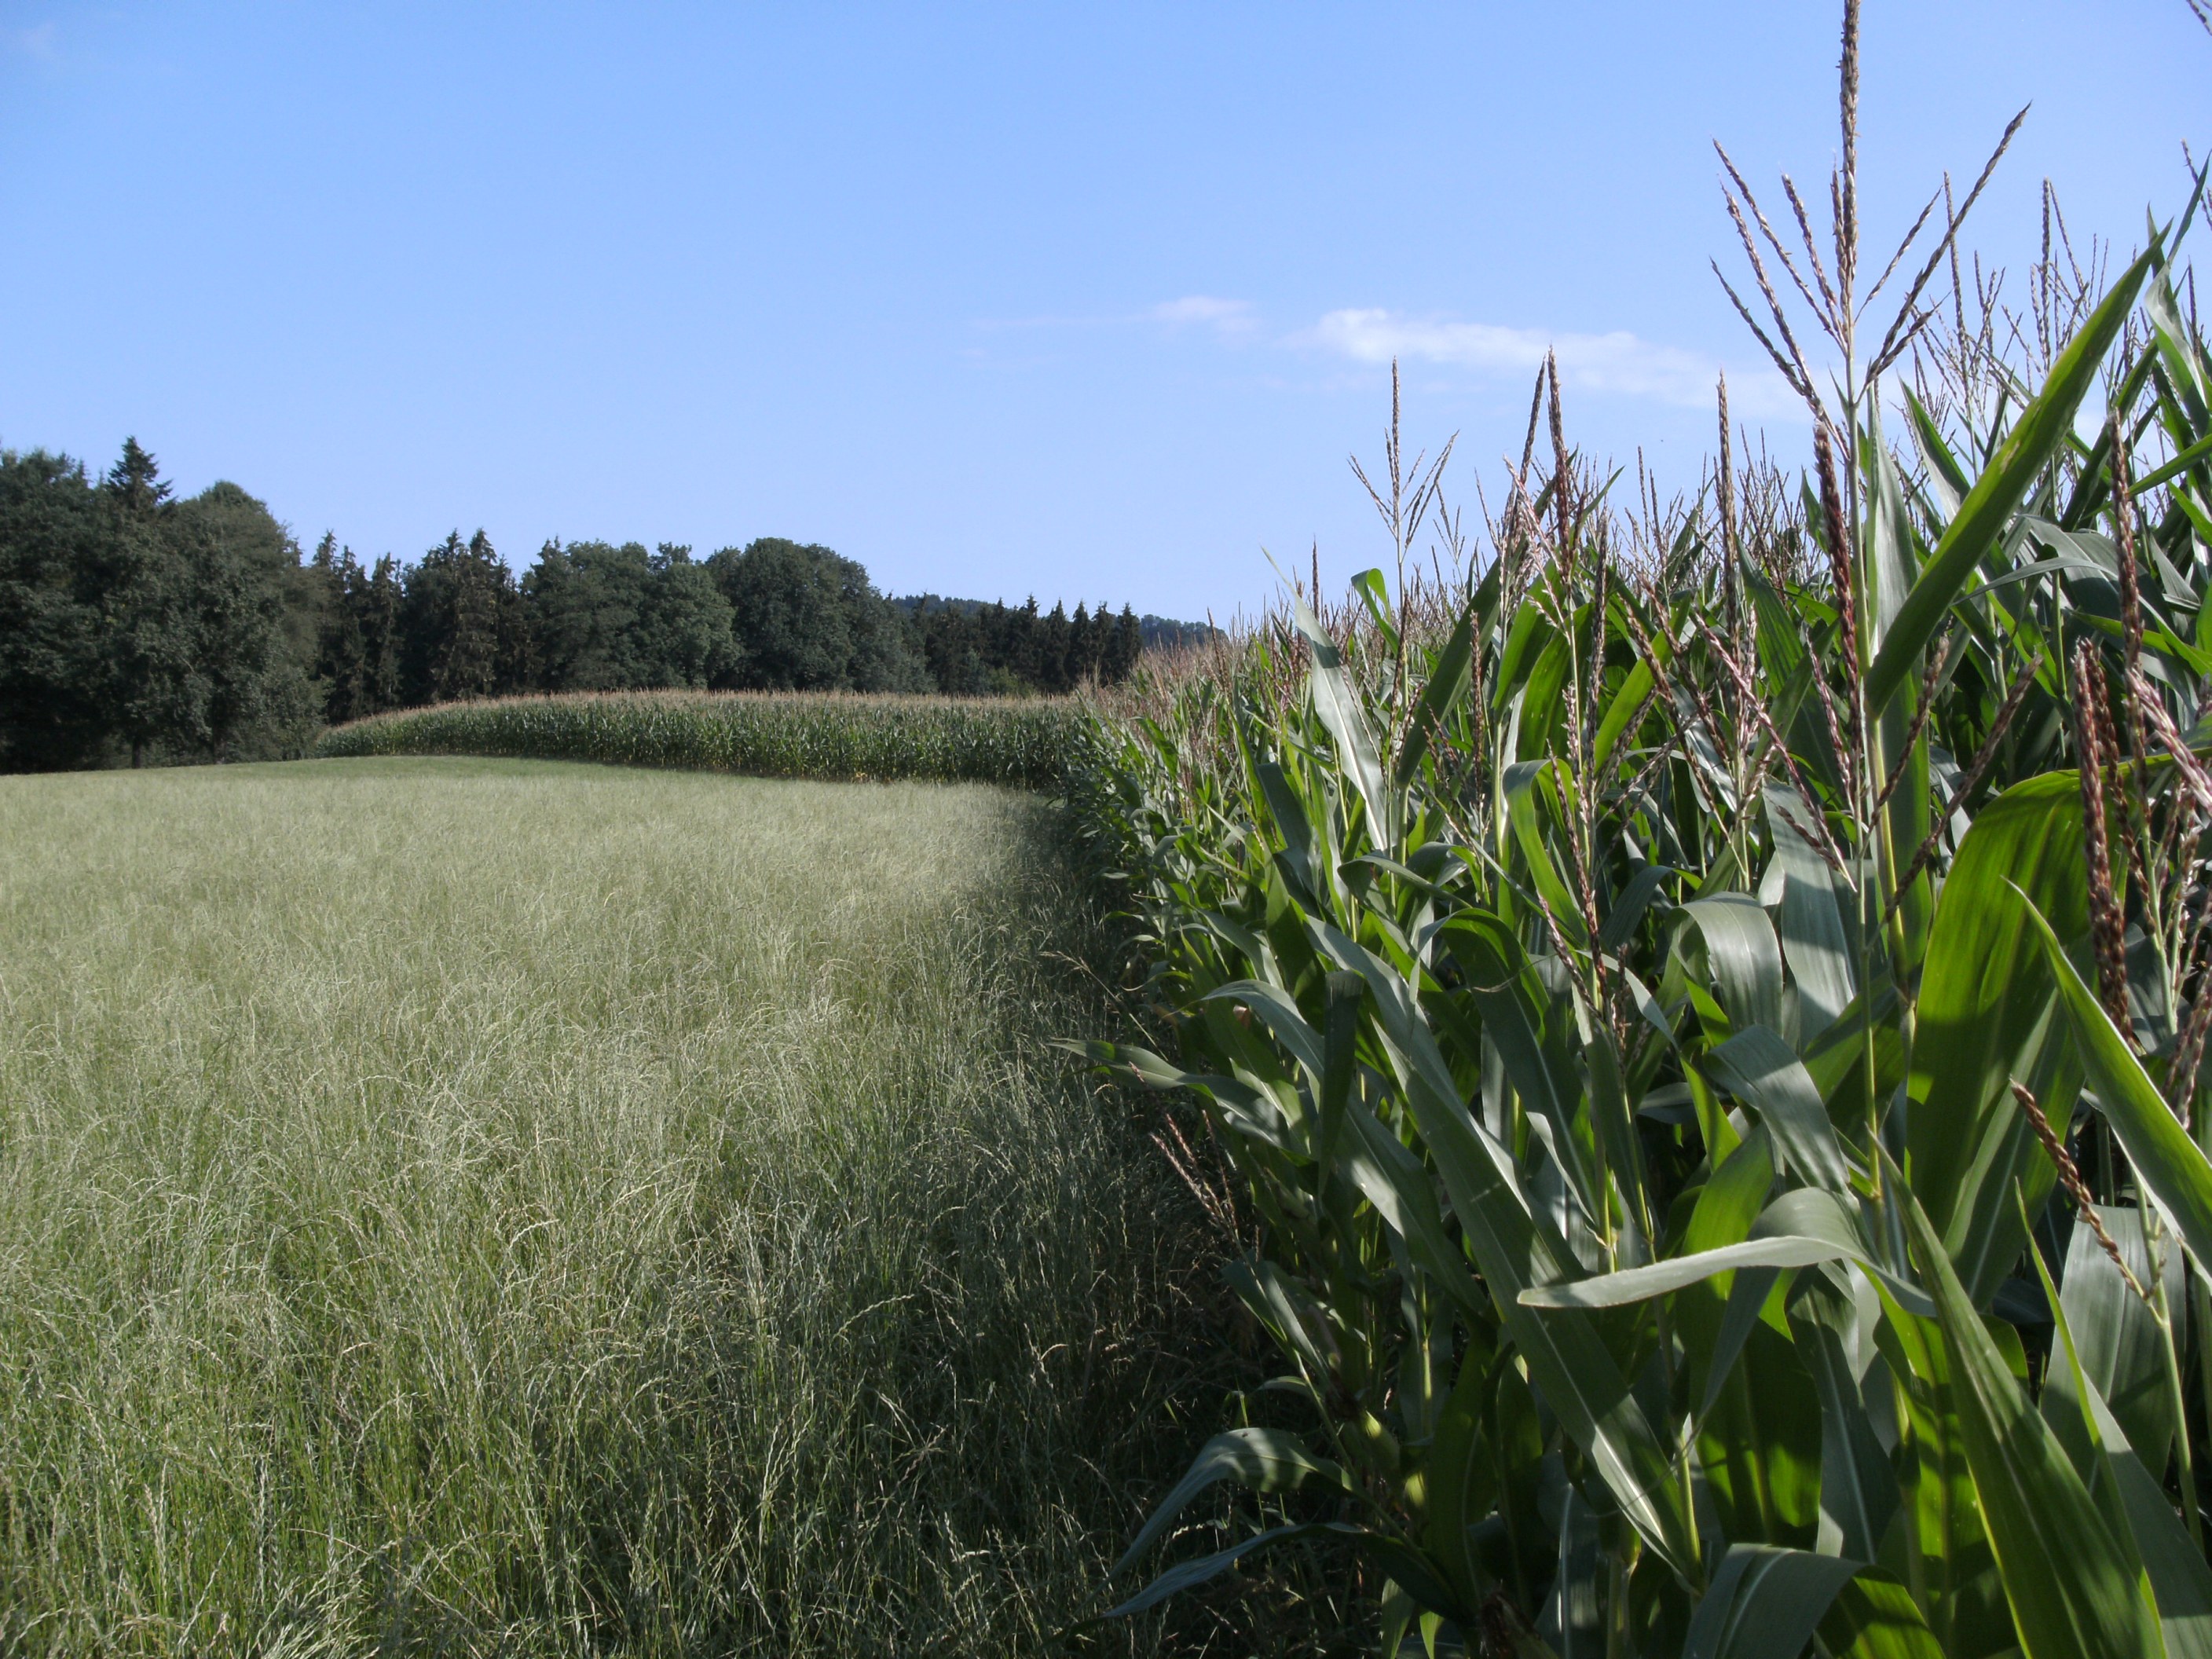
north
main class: Grassland
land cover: Grassland without tree/shrub cover
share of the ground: > 75 %
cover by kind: herbaceous plants 100 %
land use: Agriculture (excluding fallow land and kitchen gardens)
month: July
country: AT
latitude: 48.2576
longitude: 13.5149
